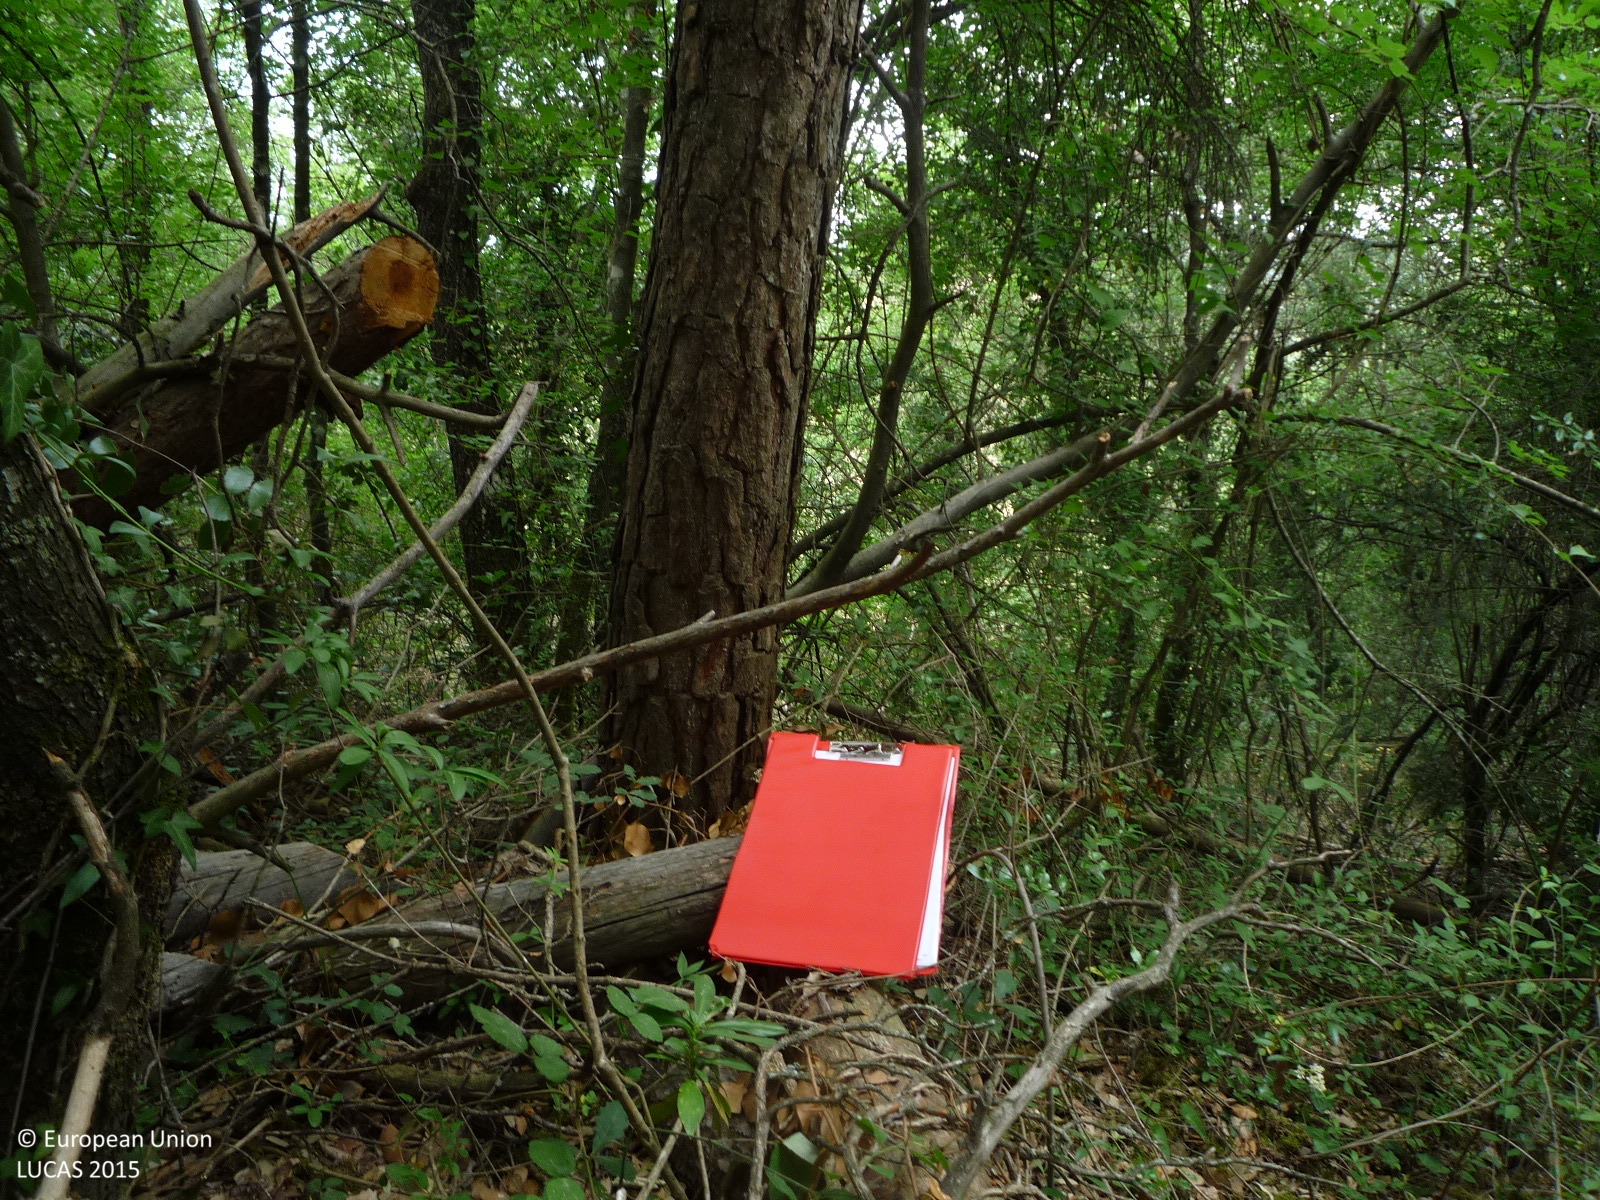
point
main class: Woodland
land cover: Pine dominated mixed woodland
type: coniferous forest of the mediterranean region
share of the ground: > 75 %
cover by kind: coniferous forest trees 60 %, broadleaved forest trees 40 %
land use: Forestry
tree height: > 5 m
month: June
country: ES
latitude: 41.8118
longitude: 2.0102
